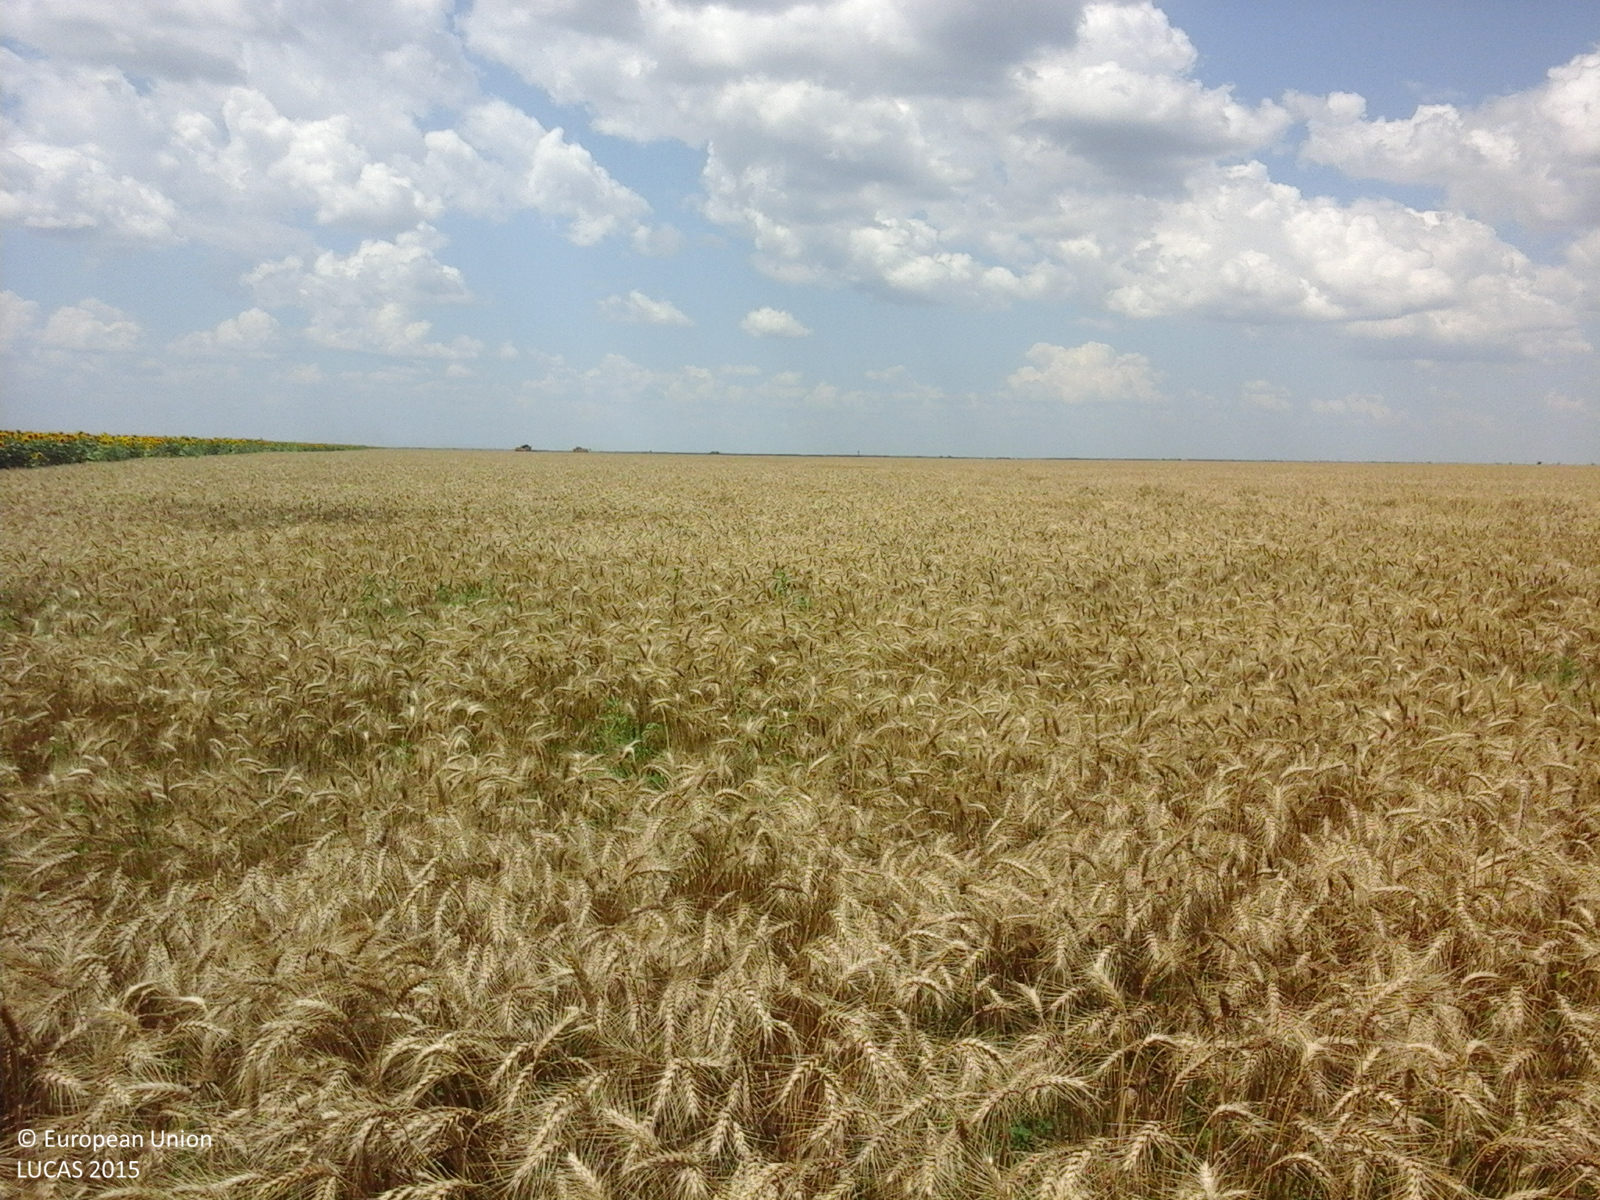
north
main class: Cropland
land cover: Common wheat
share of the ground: > 75 %
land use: Agriculture (excluding fallow land and kitchen gardens)
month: July
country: RO
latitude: 44.0036
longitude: 24.8777
